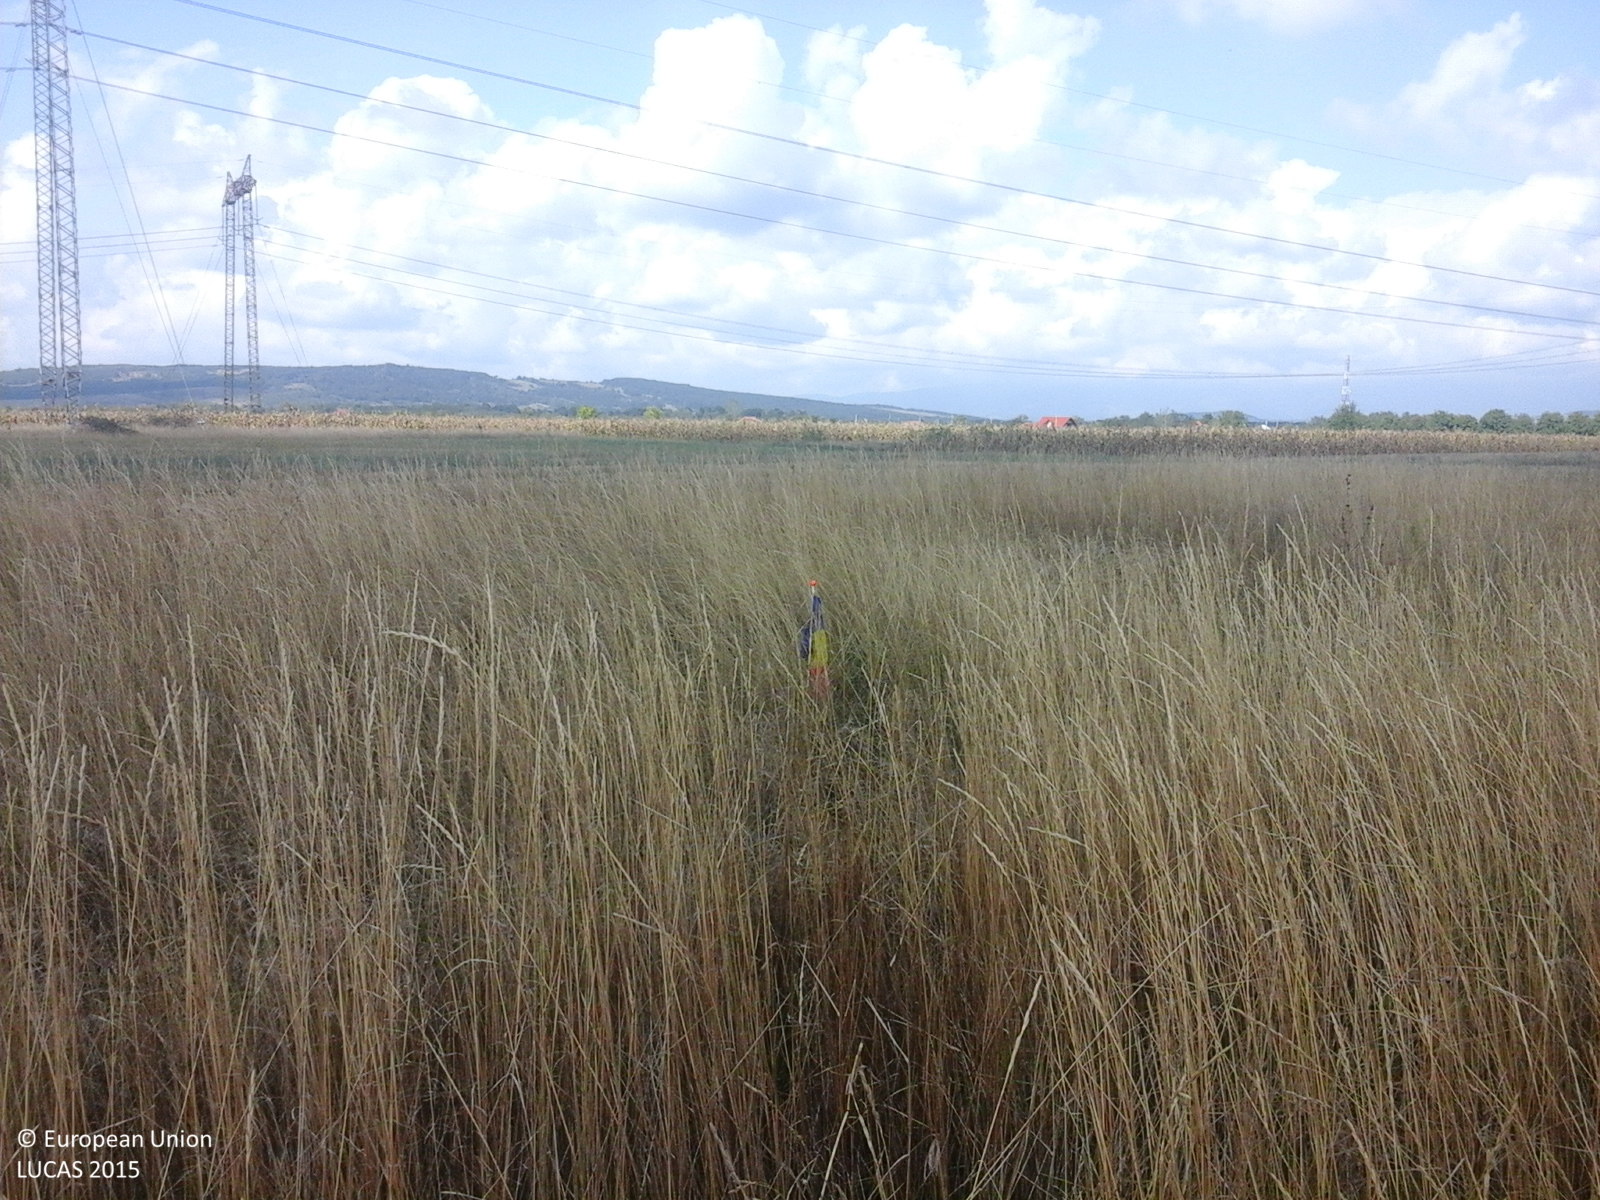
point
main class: Grassland
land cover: Spontaneously vegetated surfaces
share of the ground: > 75 %
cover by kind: herbaceous plants 100 %
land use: Fallow land
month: September
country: RO
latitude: 45.0278
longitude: 23.5499
